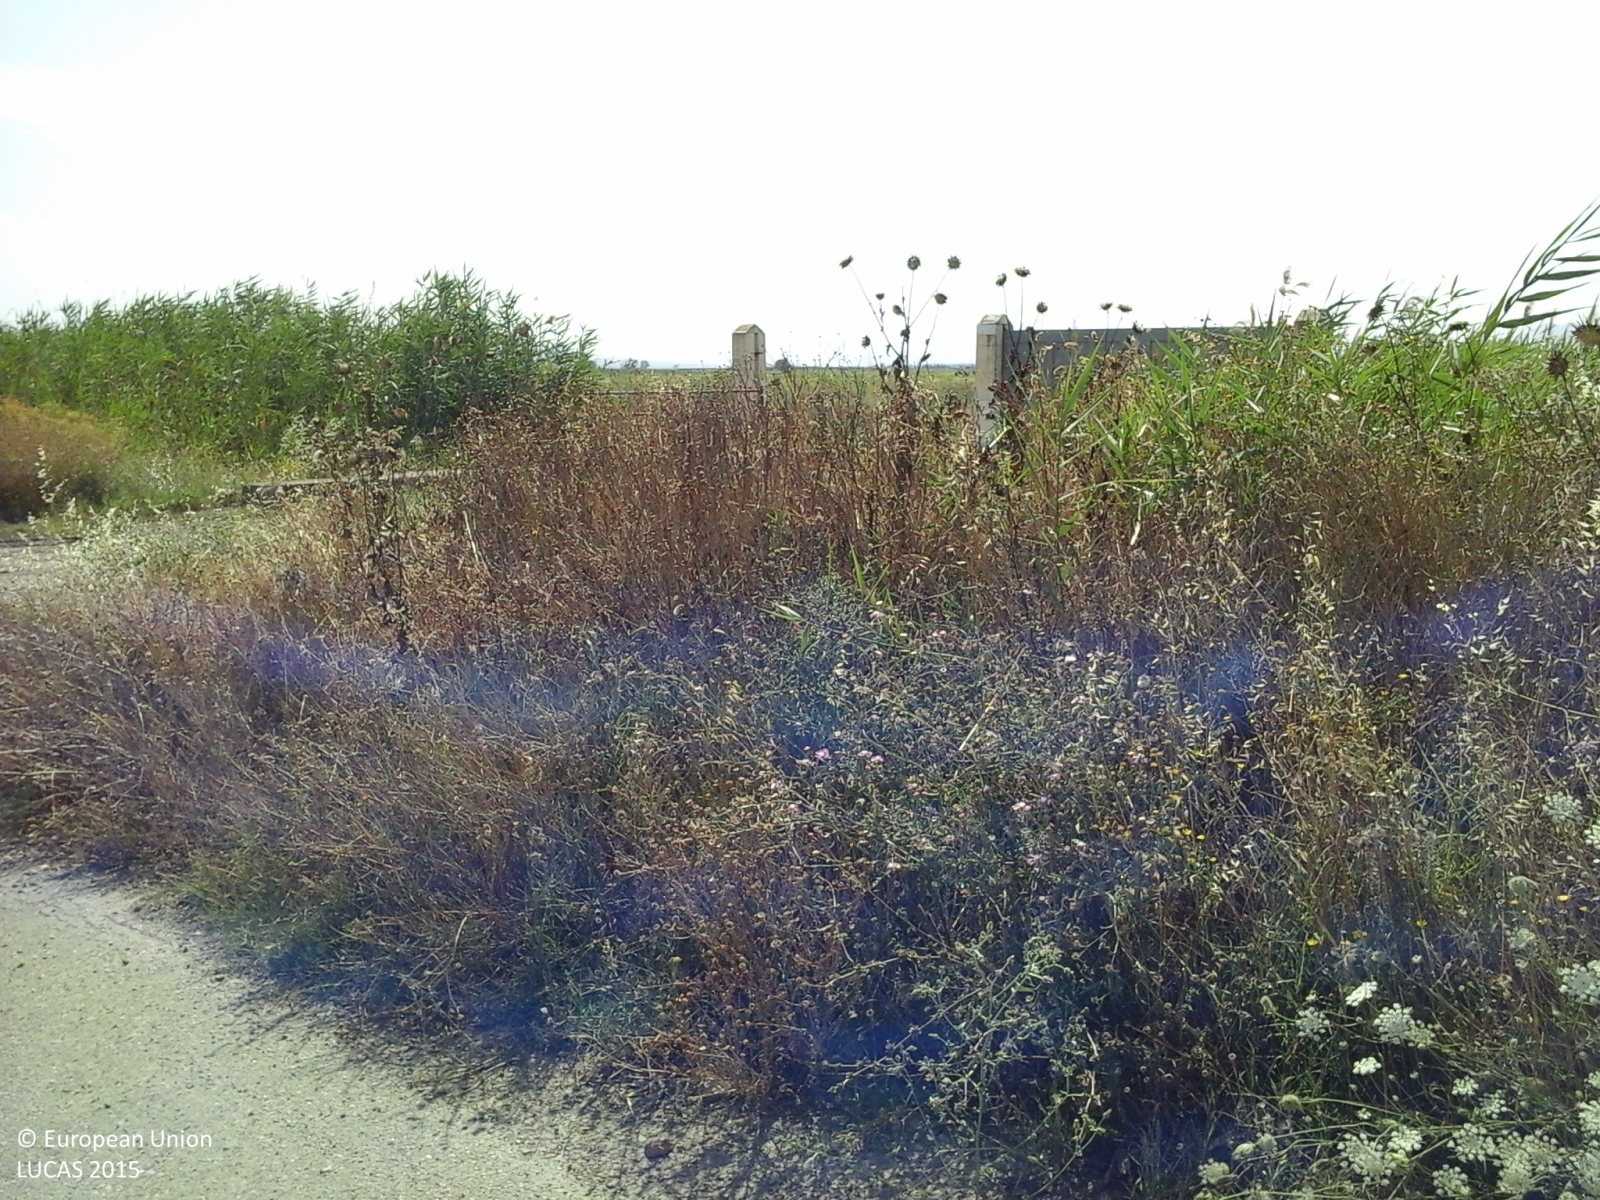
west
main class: Cropland
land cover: Oranges
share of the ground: > 75 %
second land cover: Spontaneously vegetated surfaces
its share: > 75 %
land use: Agriculture (excluding fallow land and kitchen gardens)
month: June
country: IT
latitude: 37.4415
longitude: 14.8585
